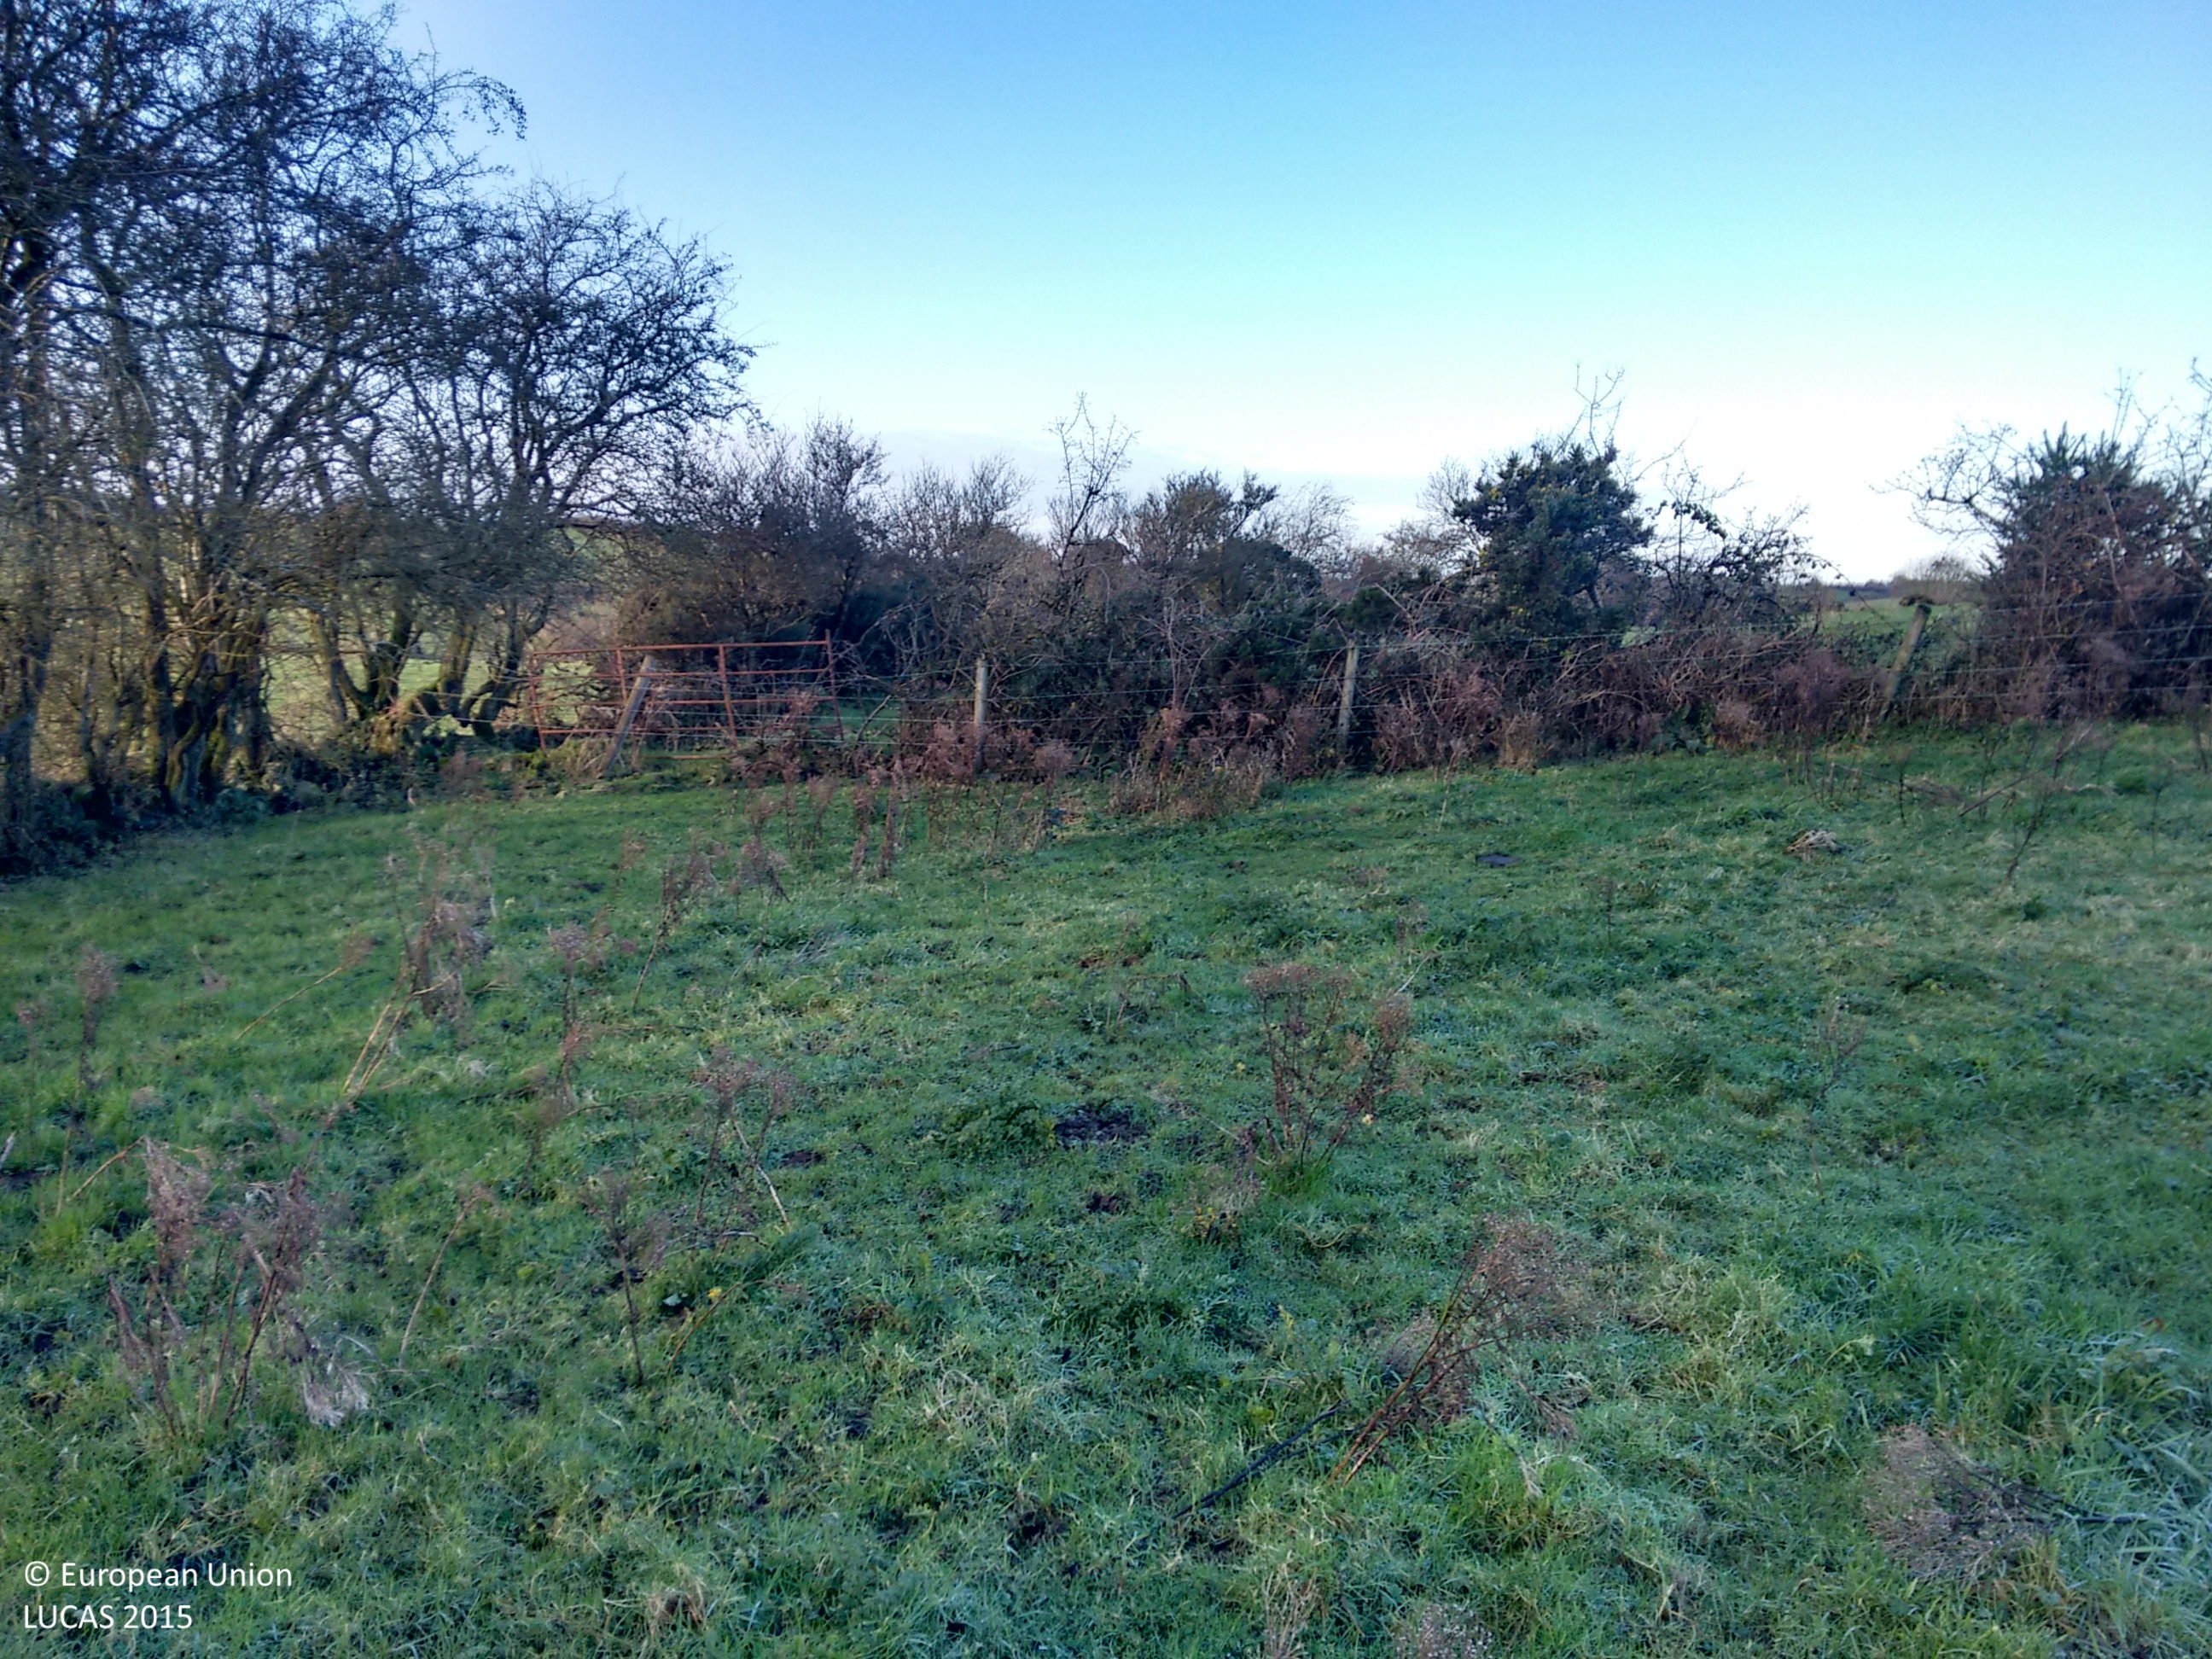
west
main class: Grassland
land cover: Grassland without tree/shrub cover
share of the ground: > 75 %
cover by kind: herbaceous plants 100 %
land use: Agriculture (excluding fallow land and kitchen gardens)
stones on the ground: < 10 %
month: December
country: IE
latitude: 53.9773
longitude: -6.8315
